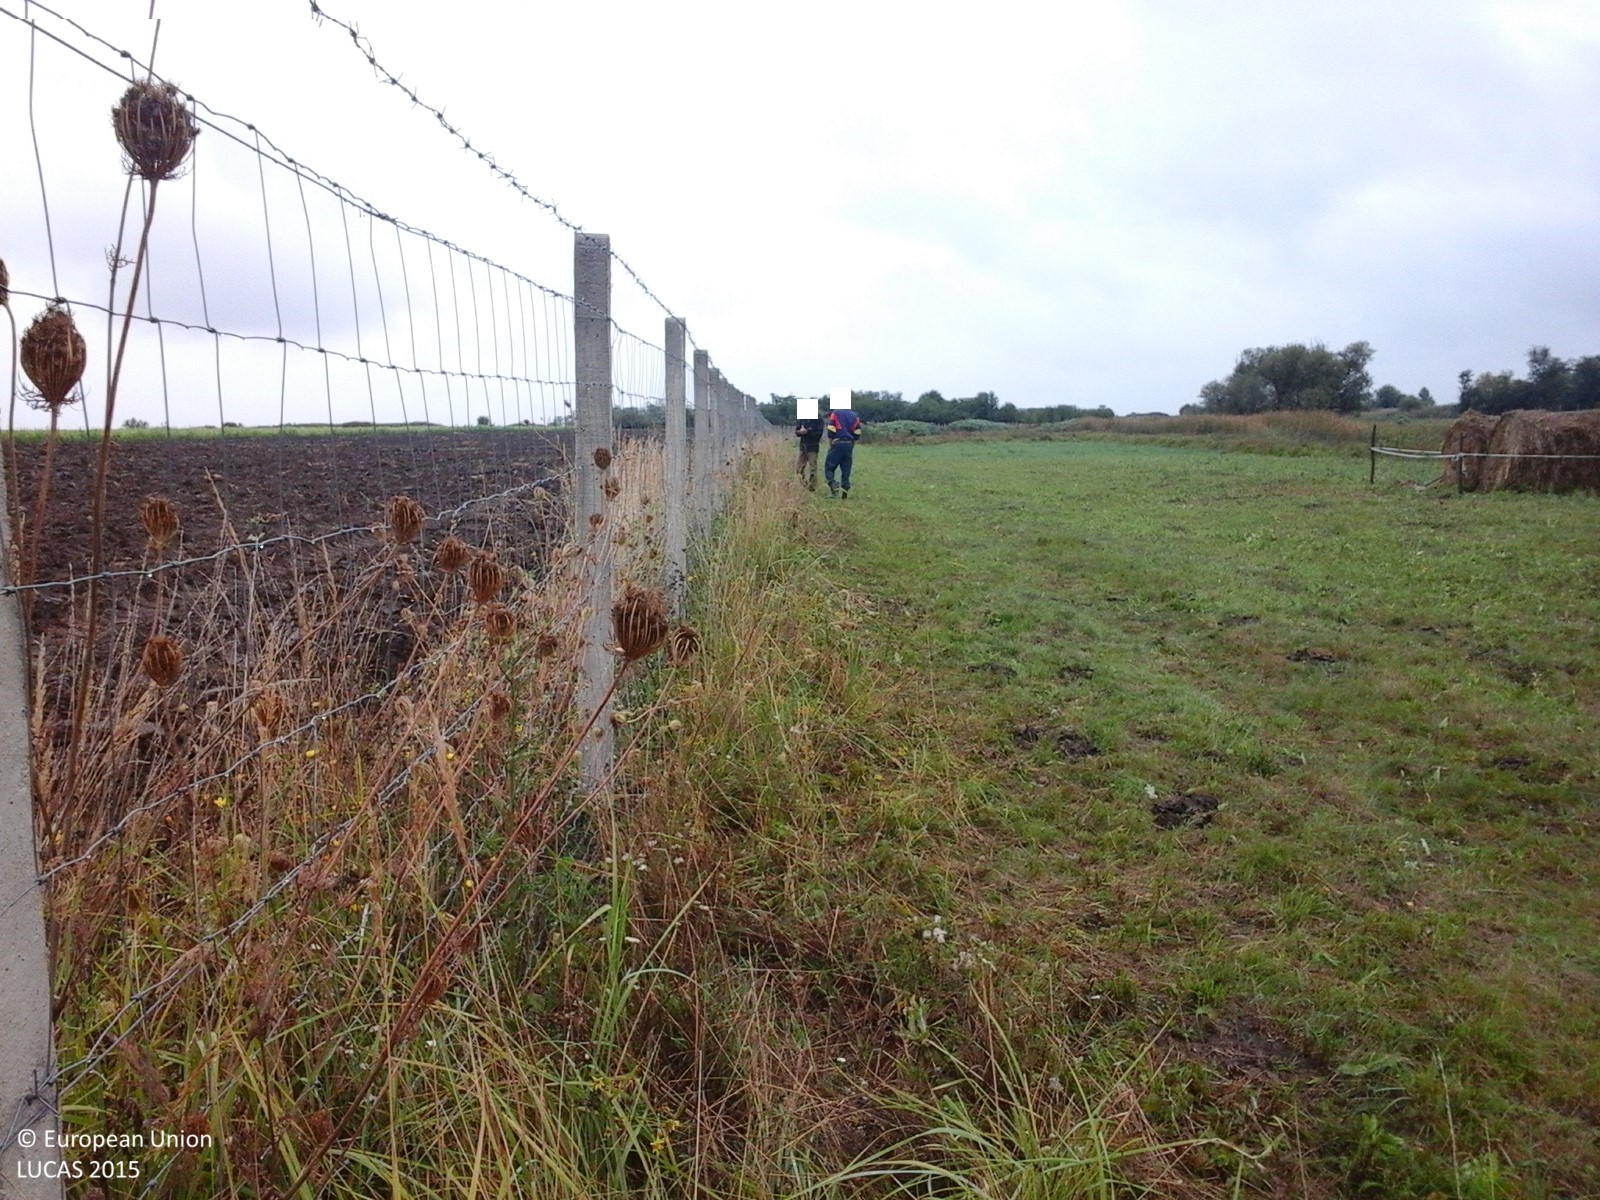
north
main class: Cropland
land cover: Maize
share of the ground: < 10 %
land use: Agriculture (excluding fallow land and kitchen gardens)
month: September
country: RO
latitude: 46.8609
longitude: 21.6237
